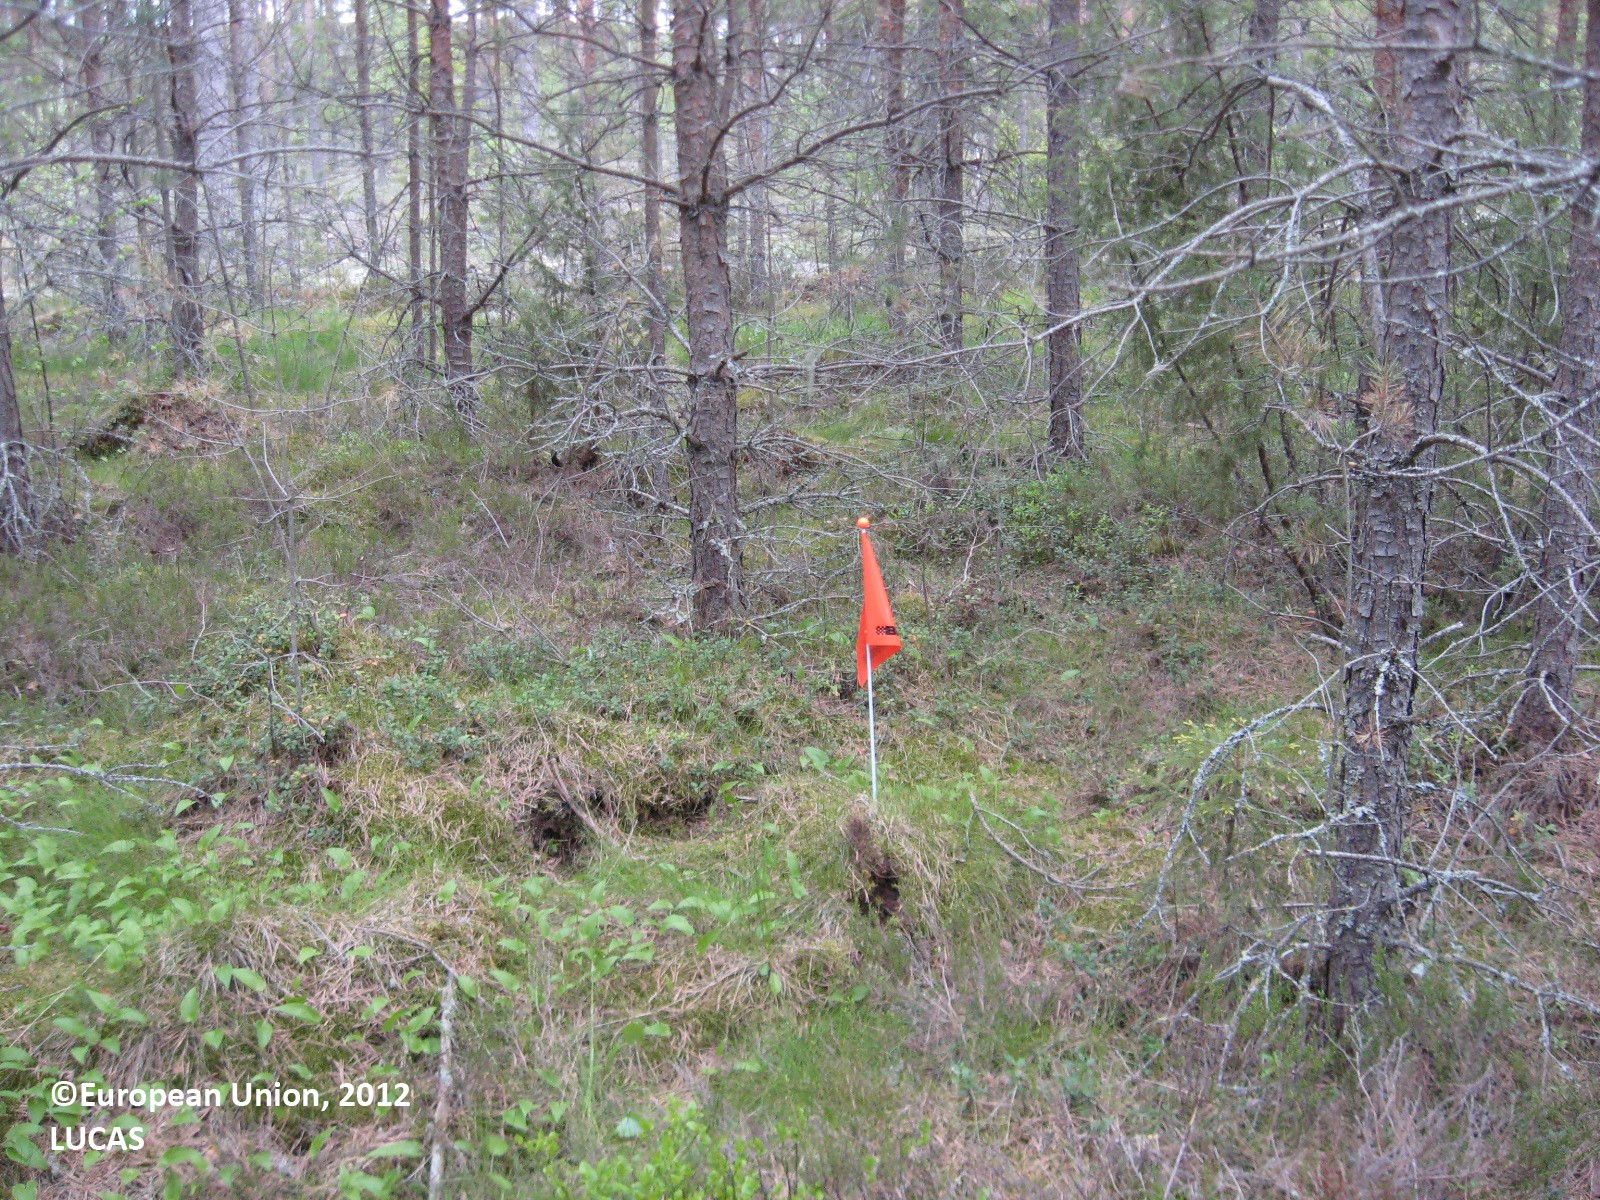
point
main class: Woodland
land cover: Pine dominated coniferous woodland
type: boreal forest
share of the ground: > 75 %
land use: Forestry
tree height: > 5 m
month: May
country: FI
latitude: 61.7687
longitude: 22.8197
